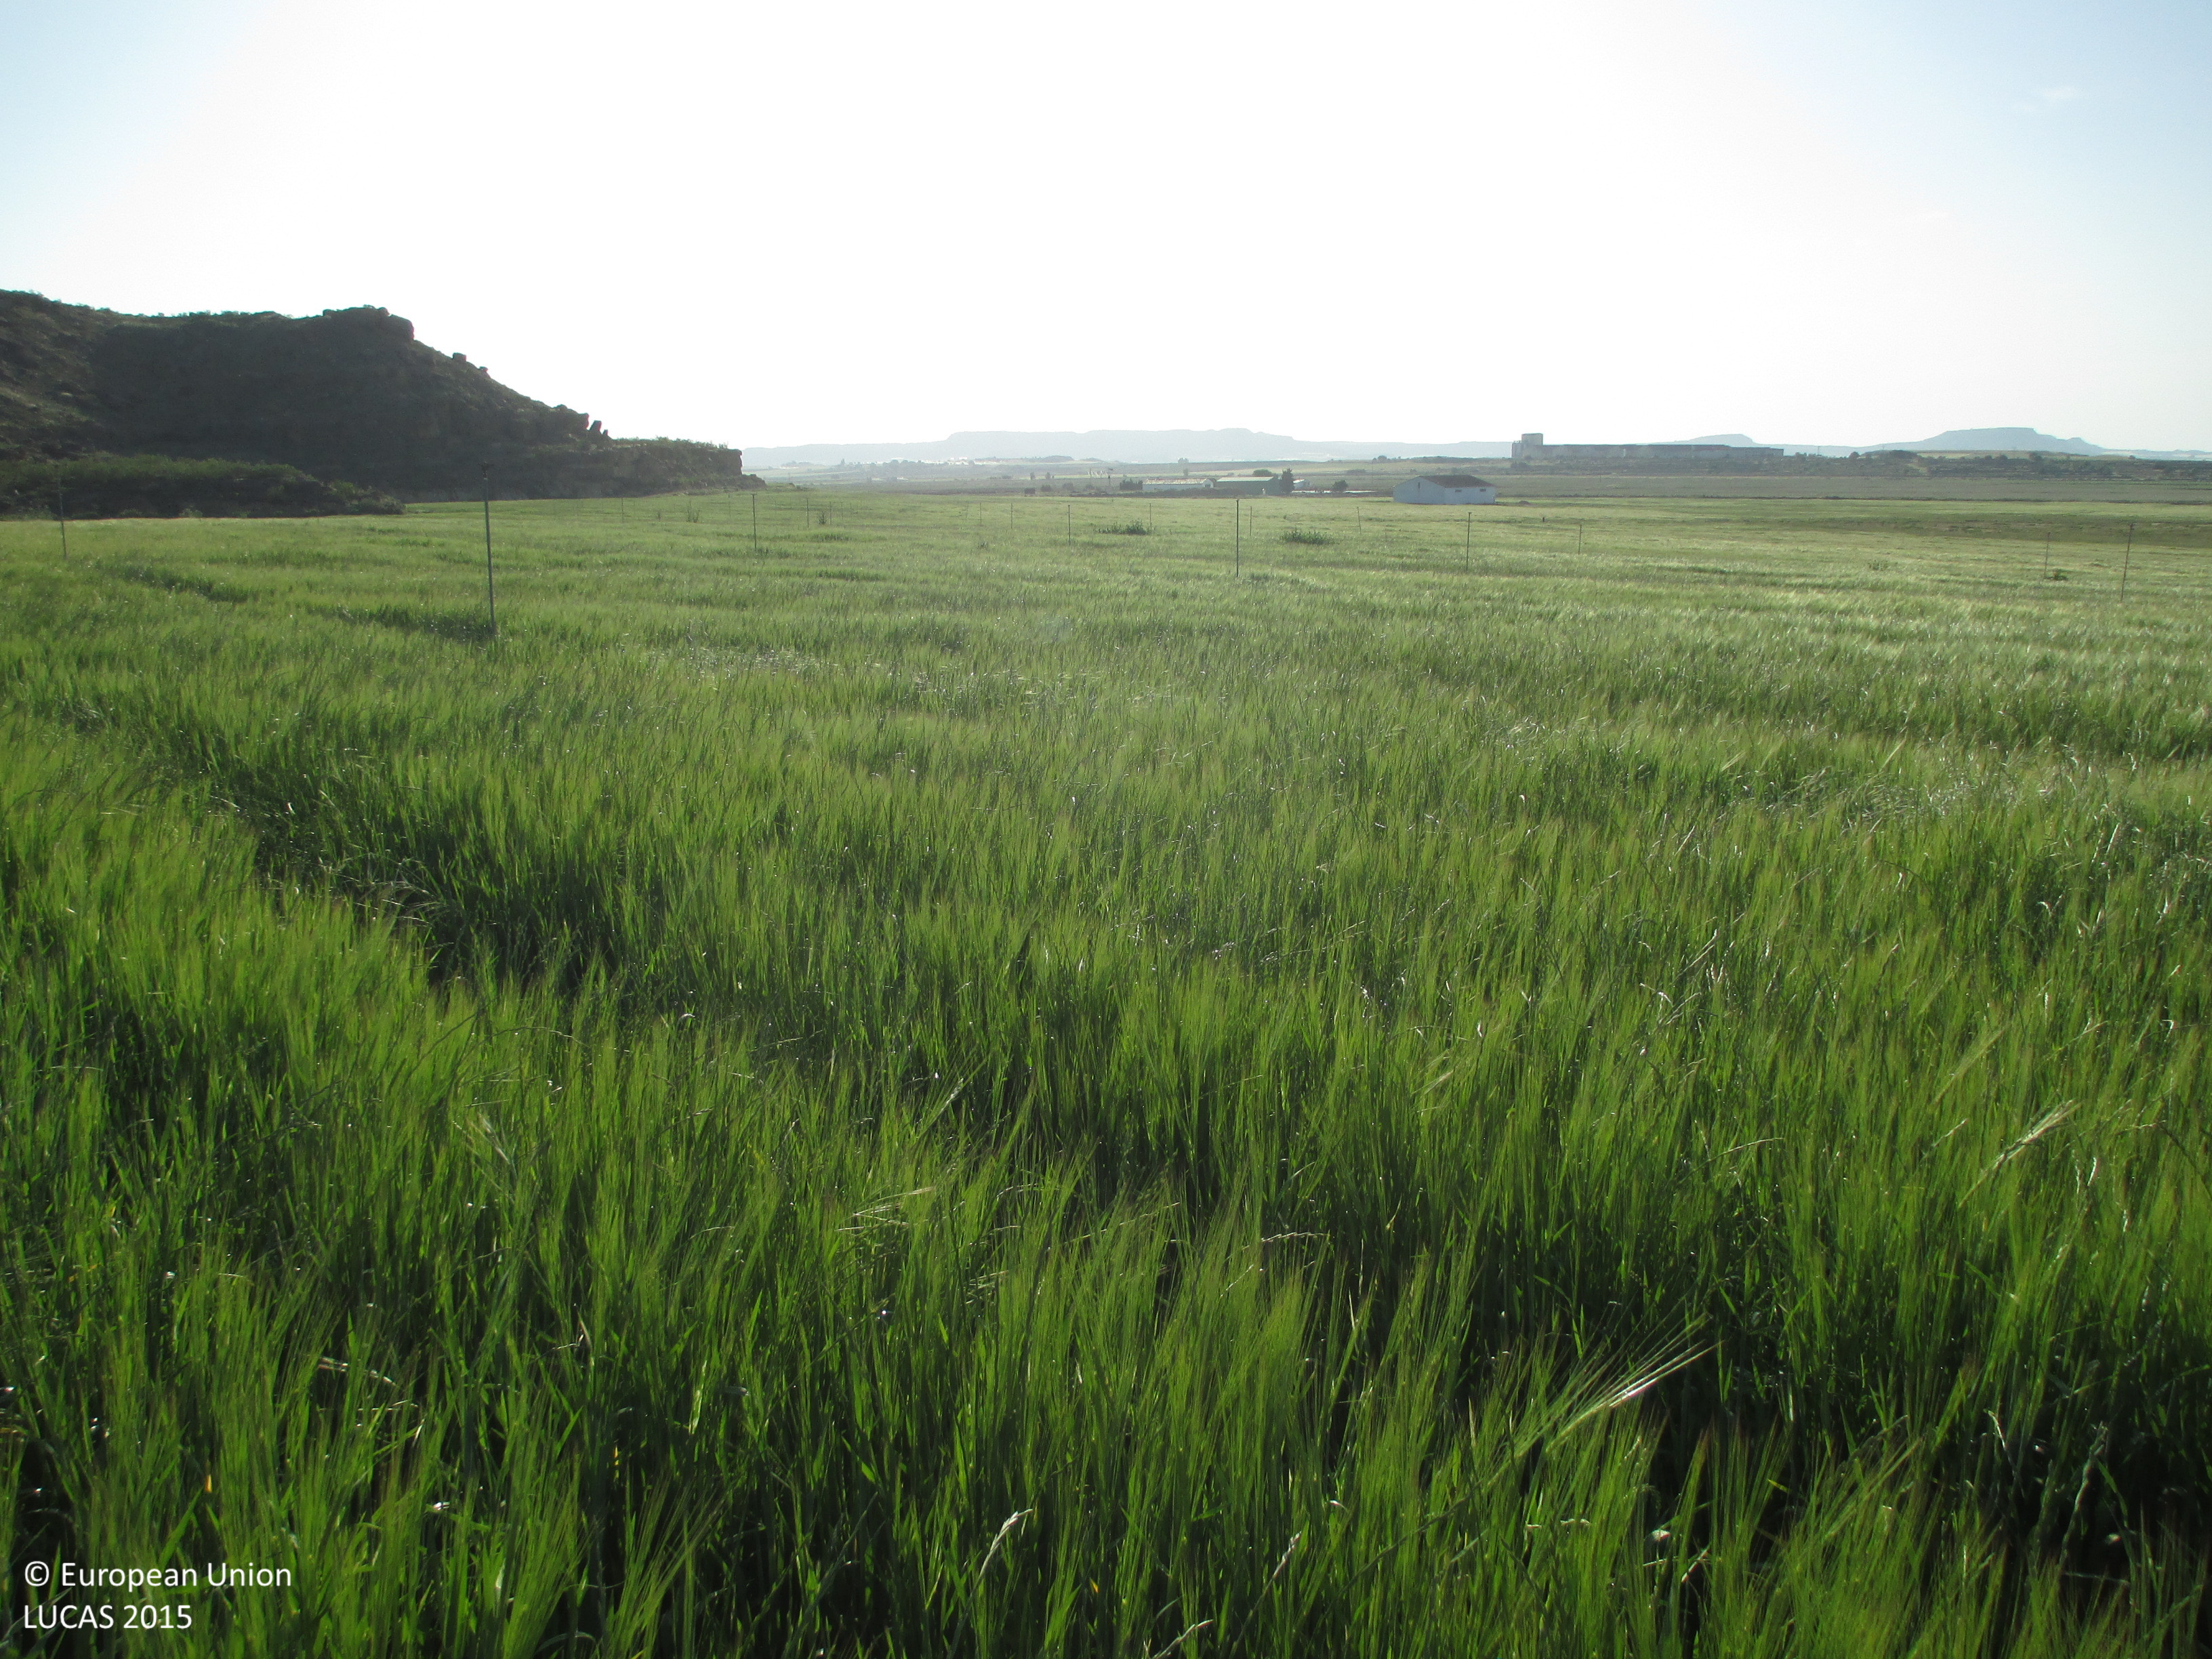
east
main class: Cropland
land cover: Barley
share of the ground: > 75 %
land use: Agriculture (excluding fallow land and kitchen gardens)
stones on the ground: < 10 %
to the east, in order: Barley; Shruby margins; Barley; Shruby margins; Barley; Shruby margins; Barley; Shruby margins; Barley; Shruby margins; Barley
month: May
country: ES
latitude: 41.9730
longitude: -0.3872
